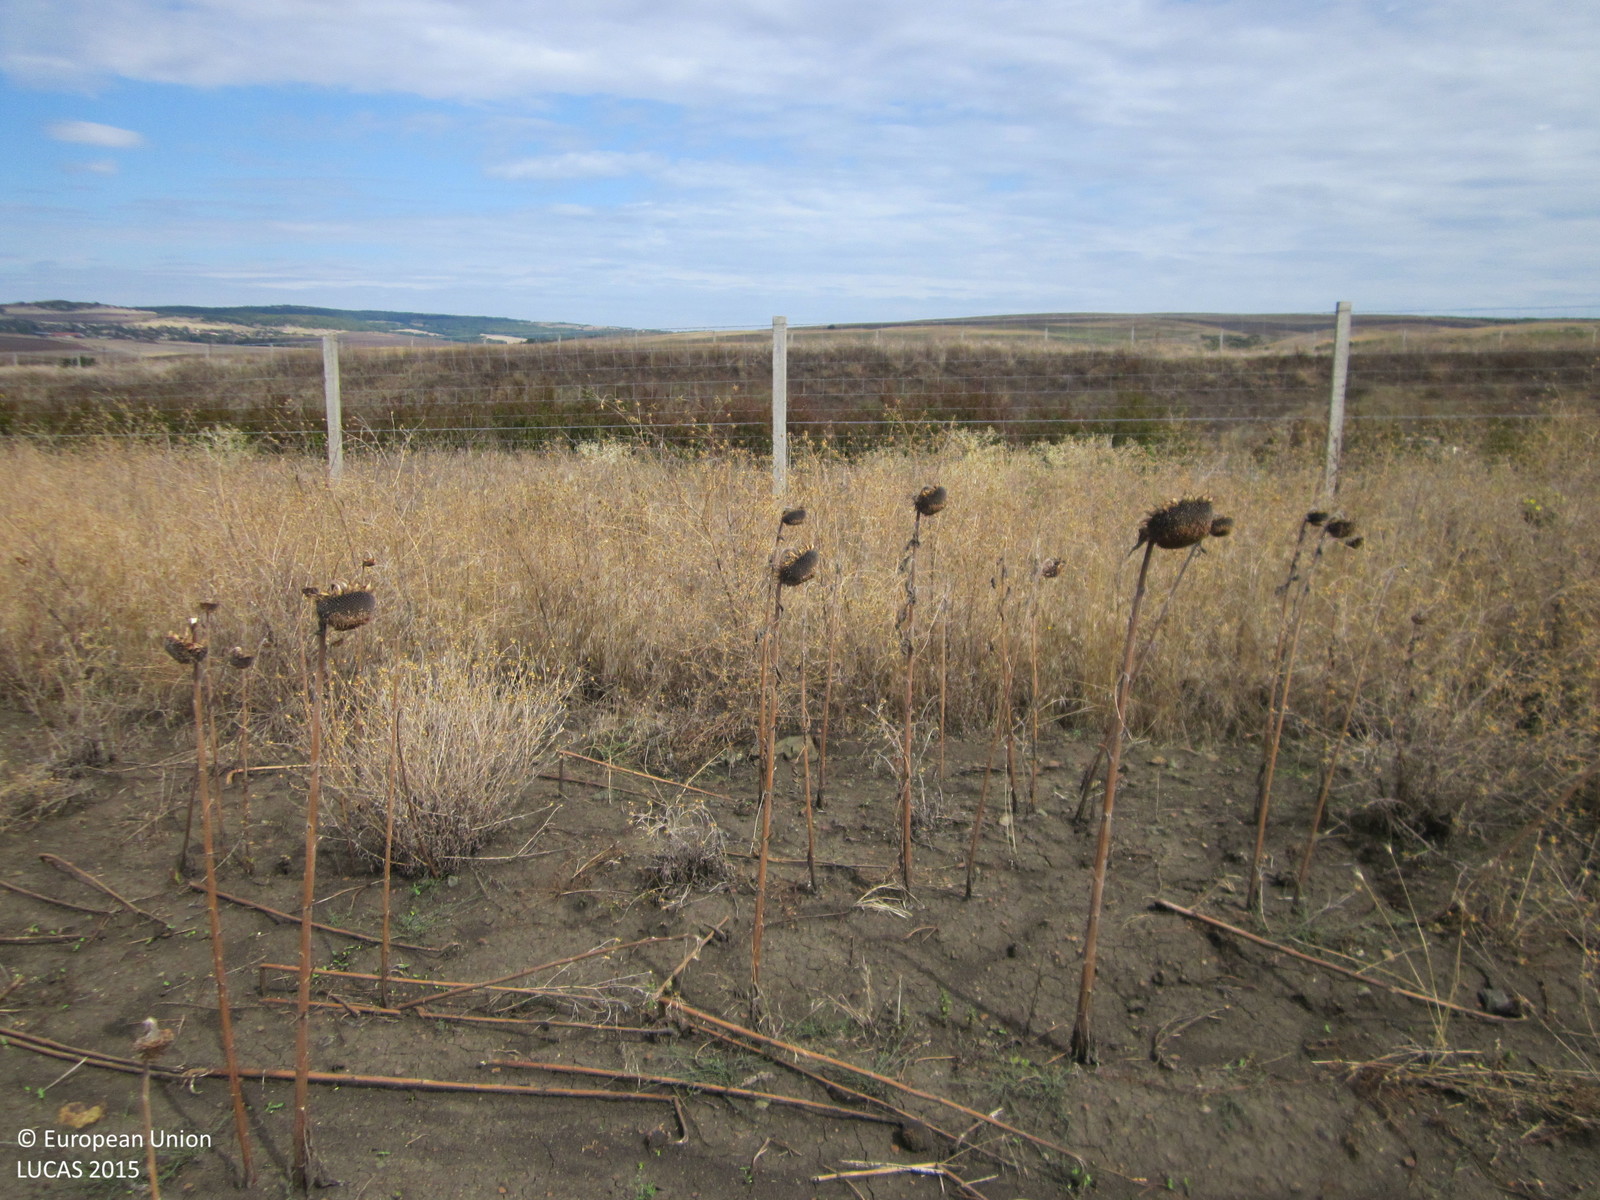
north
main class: Cropland
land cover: Sunflower
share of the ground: 50 - 75 %
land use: Agriculture (excluding fallow land and kitchen gardens)
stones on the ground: < 10 %
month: August
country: BG
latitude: 42.5857
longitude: 27.1068
